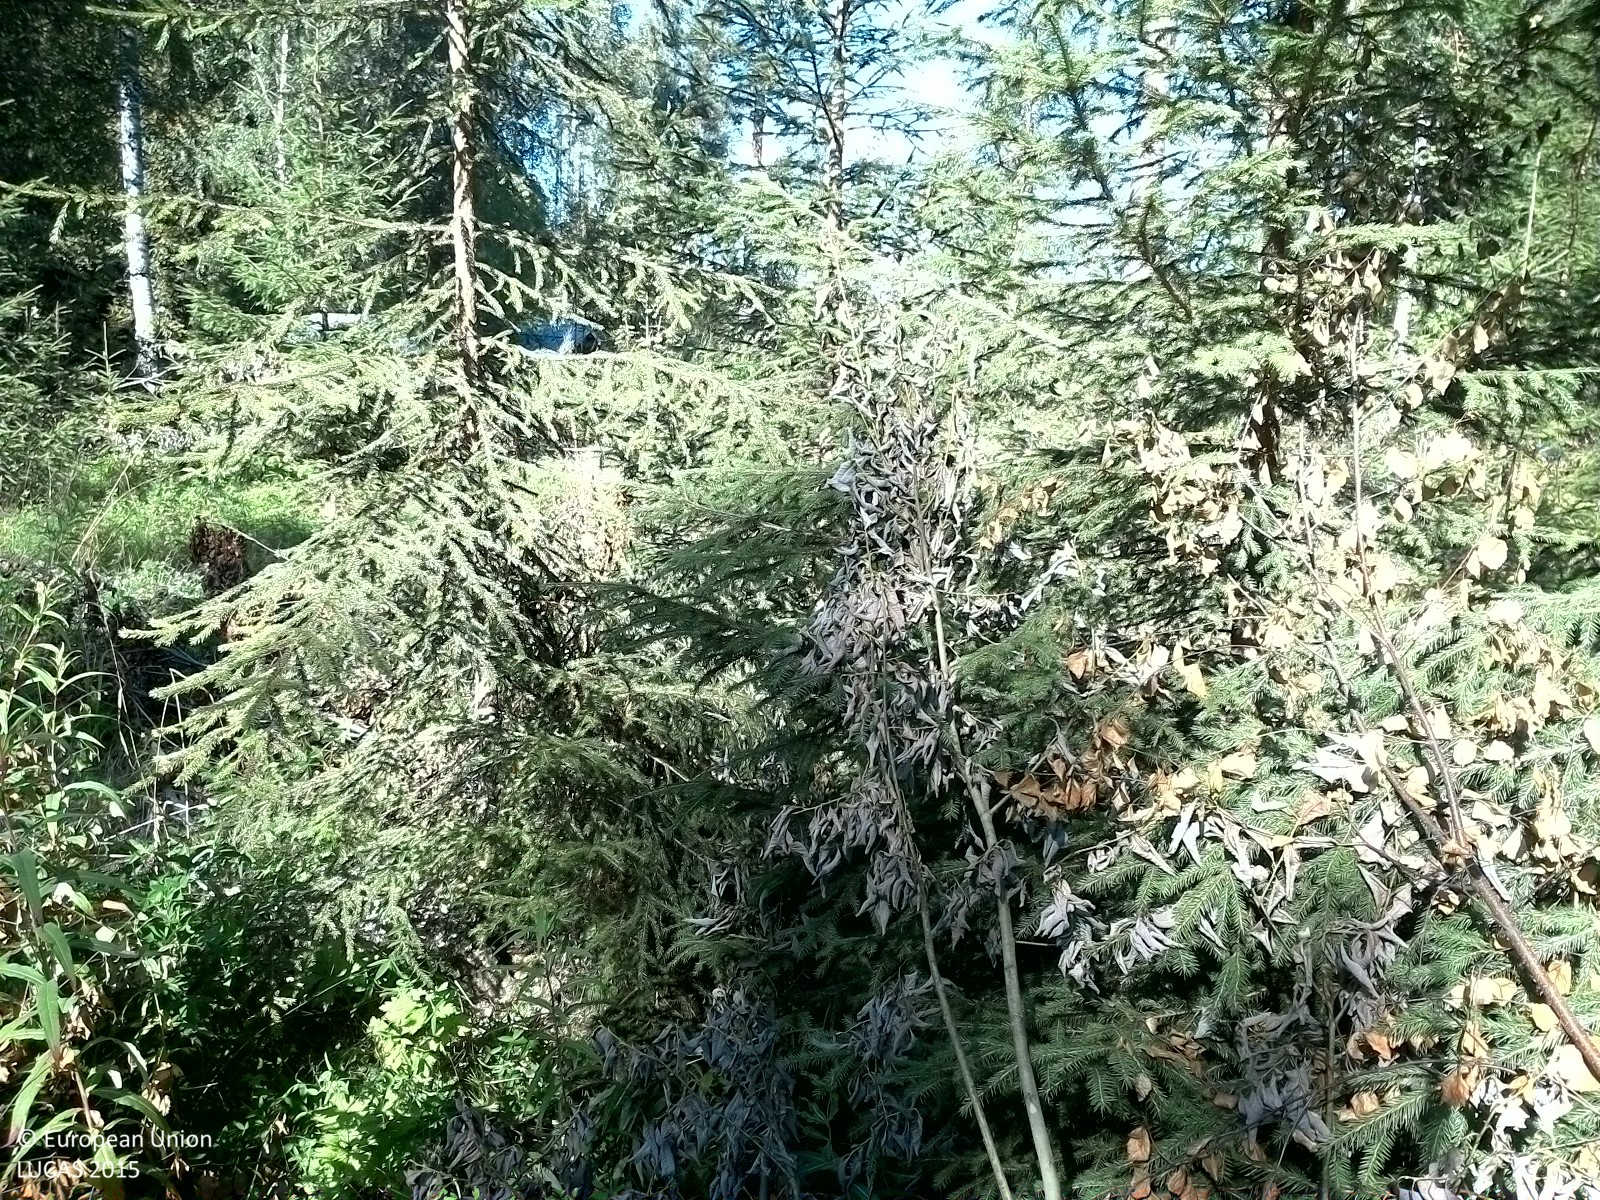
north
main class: Woodland
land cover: Spruce dominated mixed woodland
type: boreal forest
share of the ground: 50 - 75 %
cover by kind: coniferous forest trees 40 %, herbaceous plants 40 %, broadleaved forest trees 15 %
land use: Forestry
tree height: > 5 m
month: August
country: SE
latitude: 62.4039
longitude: 16.8105
